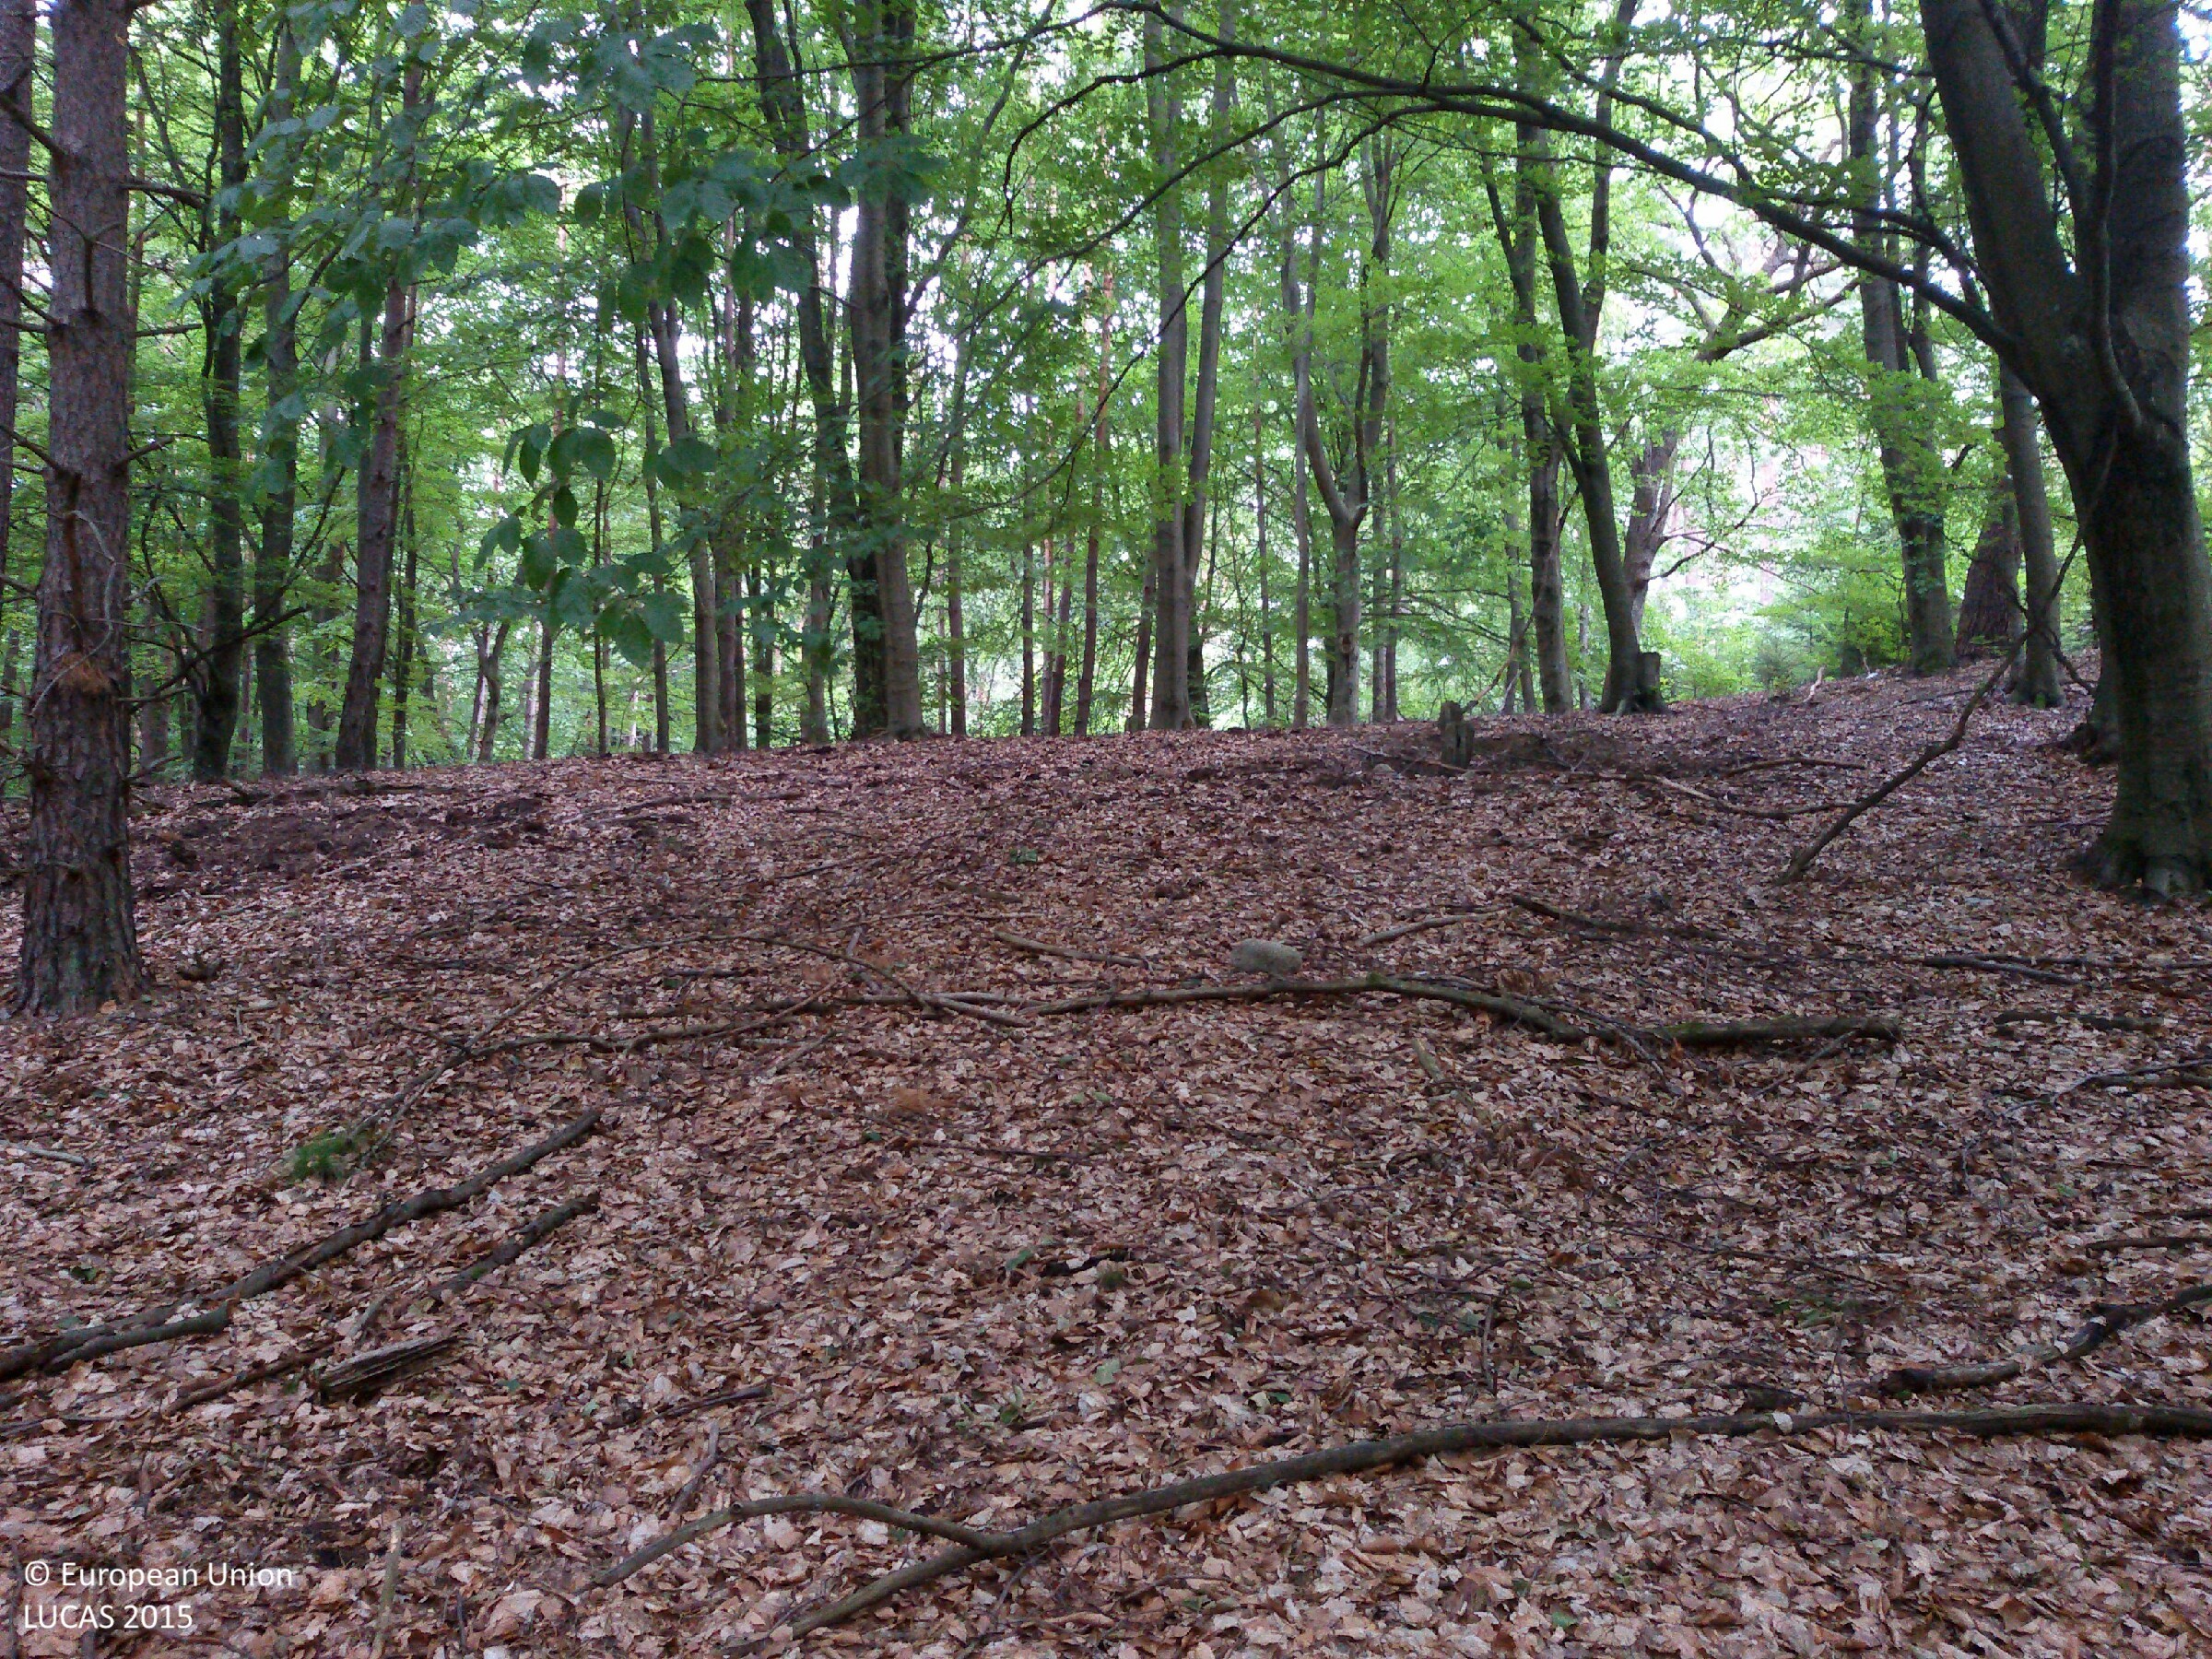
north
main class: Woodland
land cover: Other mixed woodland
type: hemiboreal forest and nemoral coniferous forest and mixed broadleaved-coniferous forest
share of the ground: > 75 %
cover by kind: broadleaved forest trees 65 %, coniferous forest trees 25 %, herbaceous plants 5 %, unconsolidated bare surface 5 %
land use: Forestry
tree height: > 5 m
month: July
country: PL
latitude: 53.1851
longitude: 16.2764
